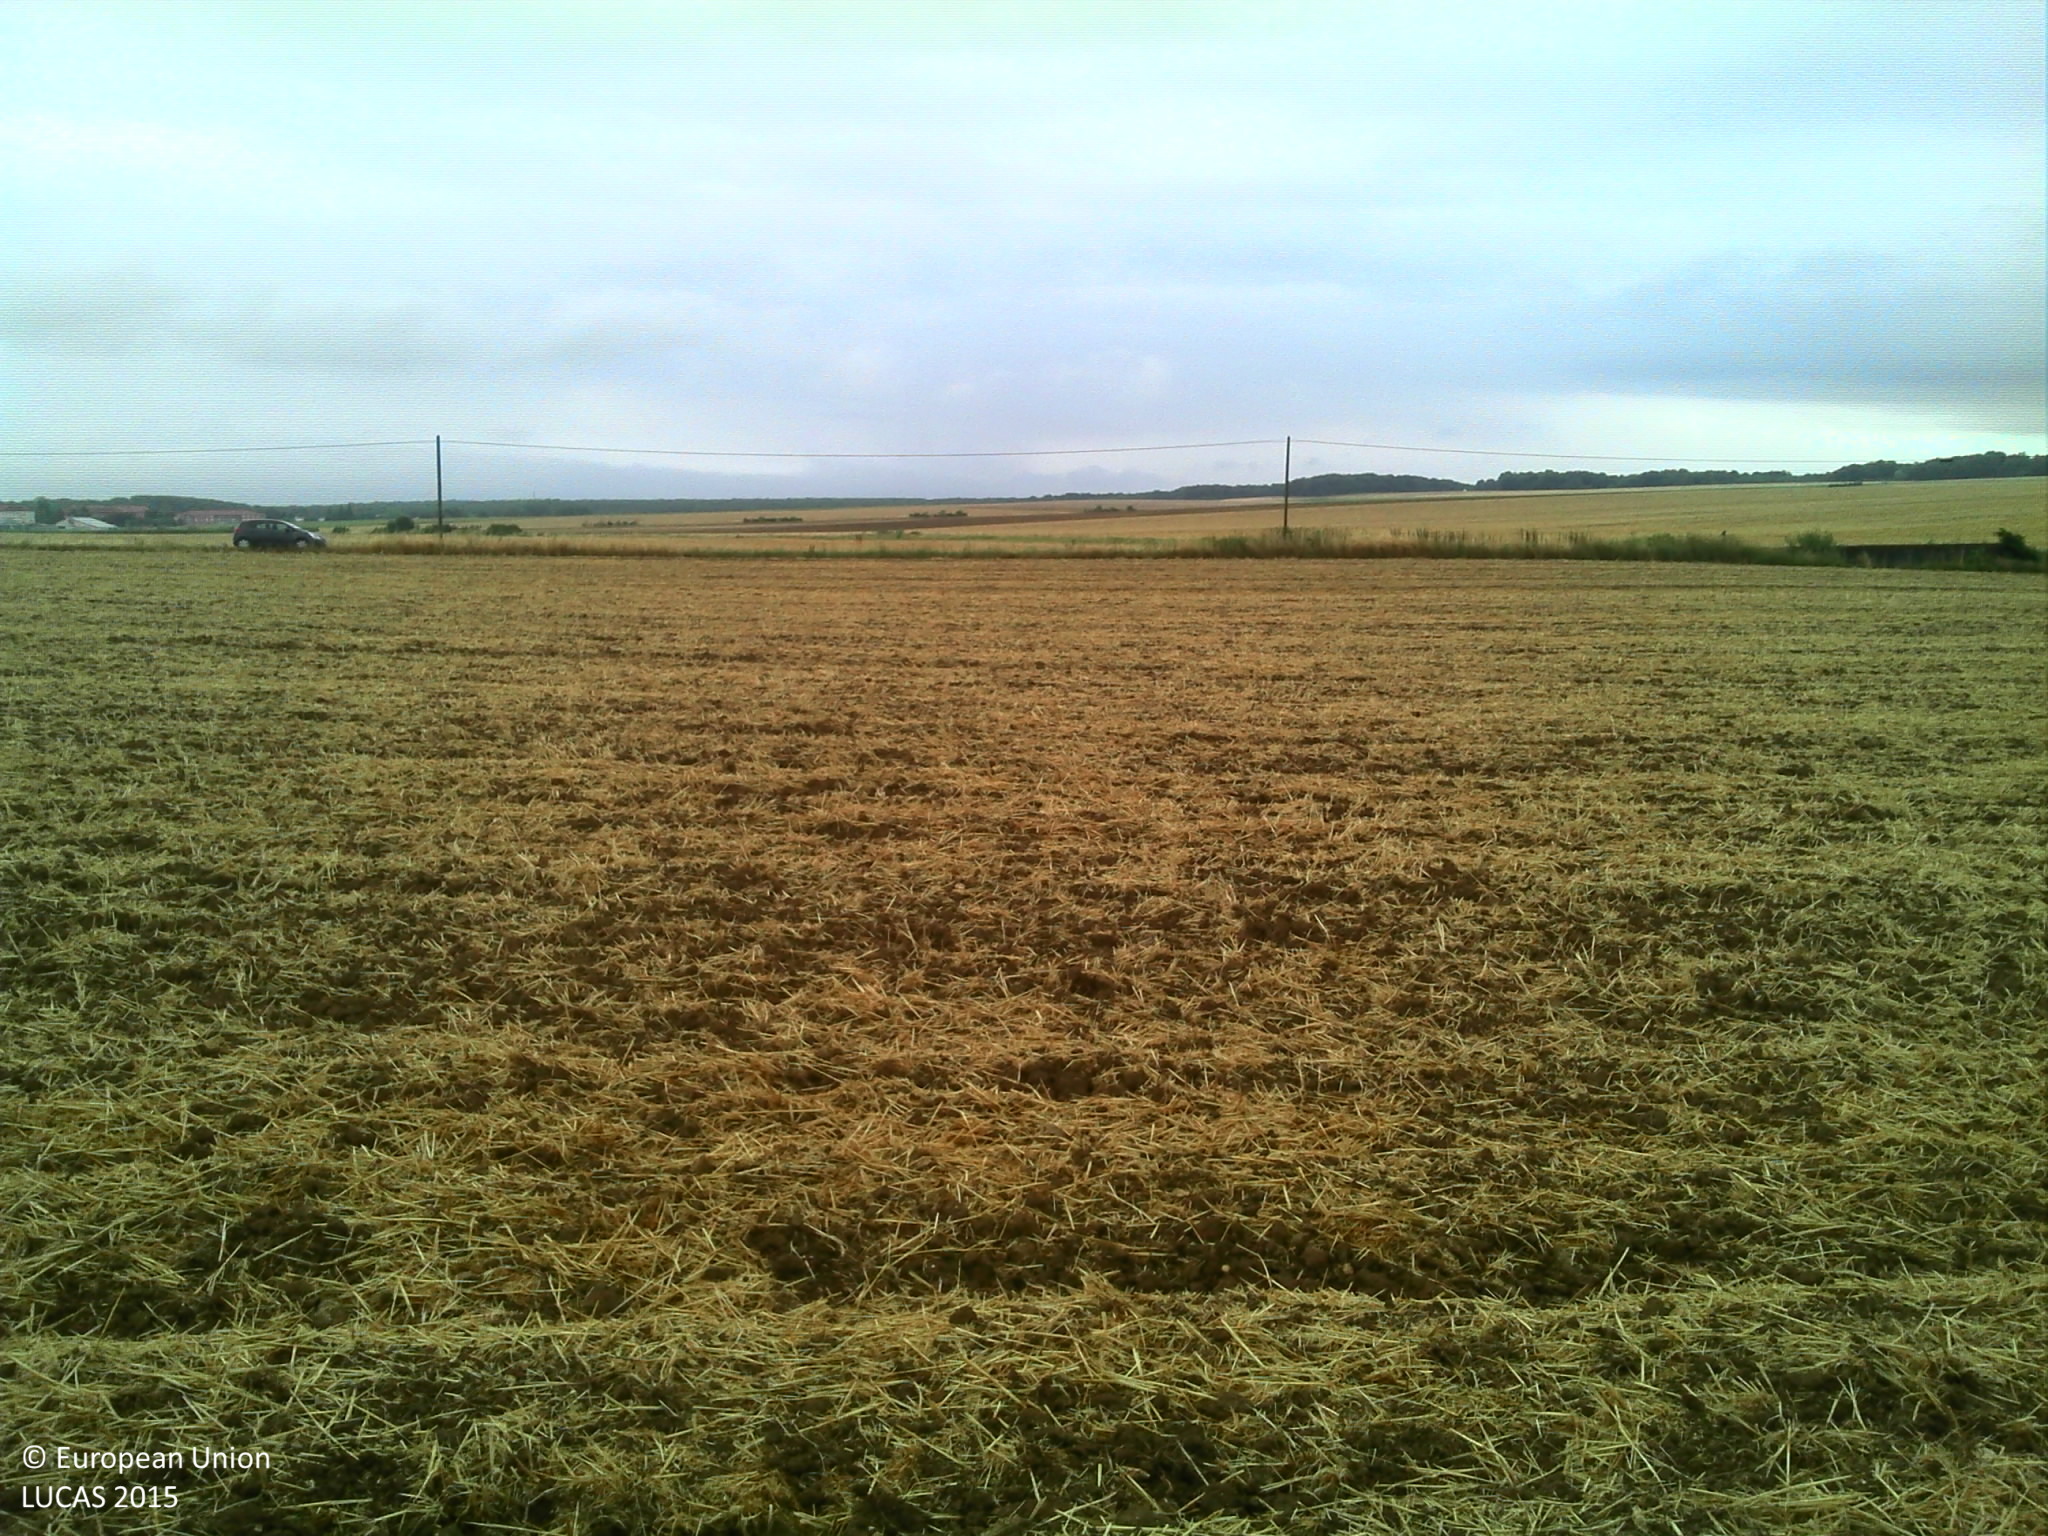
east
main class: Cropland
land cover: Common wheat
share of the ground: > 75 %
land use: Agriculture (excluding fallow land and kitchen gardens)
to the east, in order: Common wheat; Grass margins; Electric lines; Grass margins; Paved roads, cycling and walking lanes; Tracks; Common wheat
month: August
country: FR
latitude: 48.5279
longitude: 3.3446
